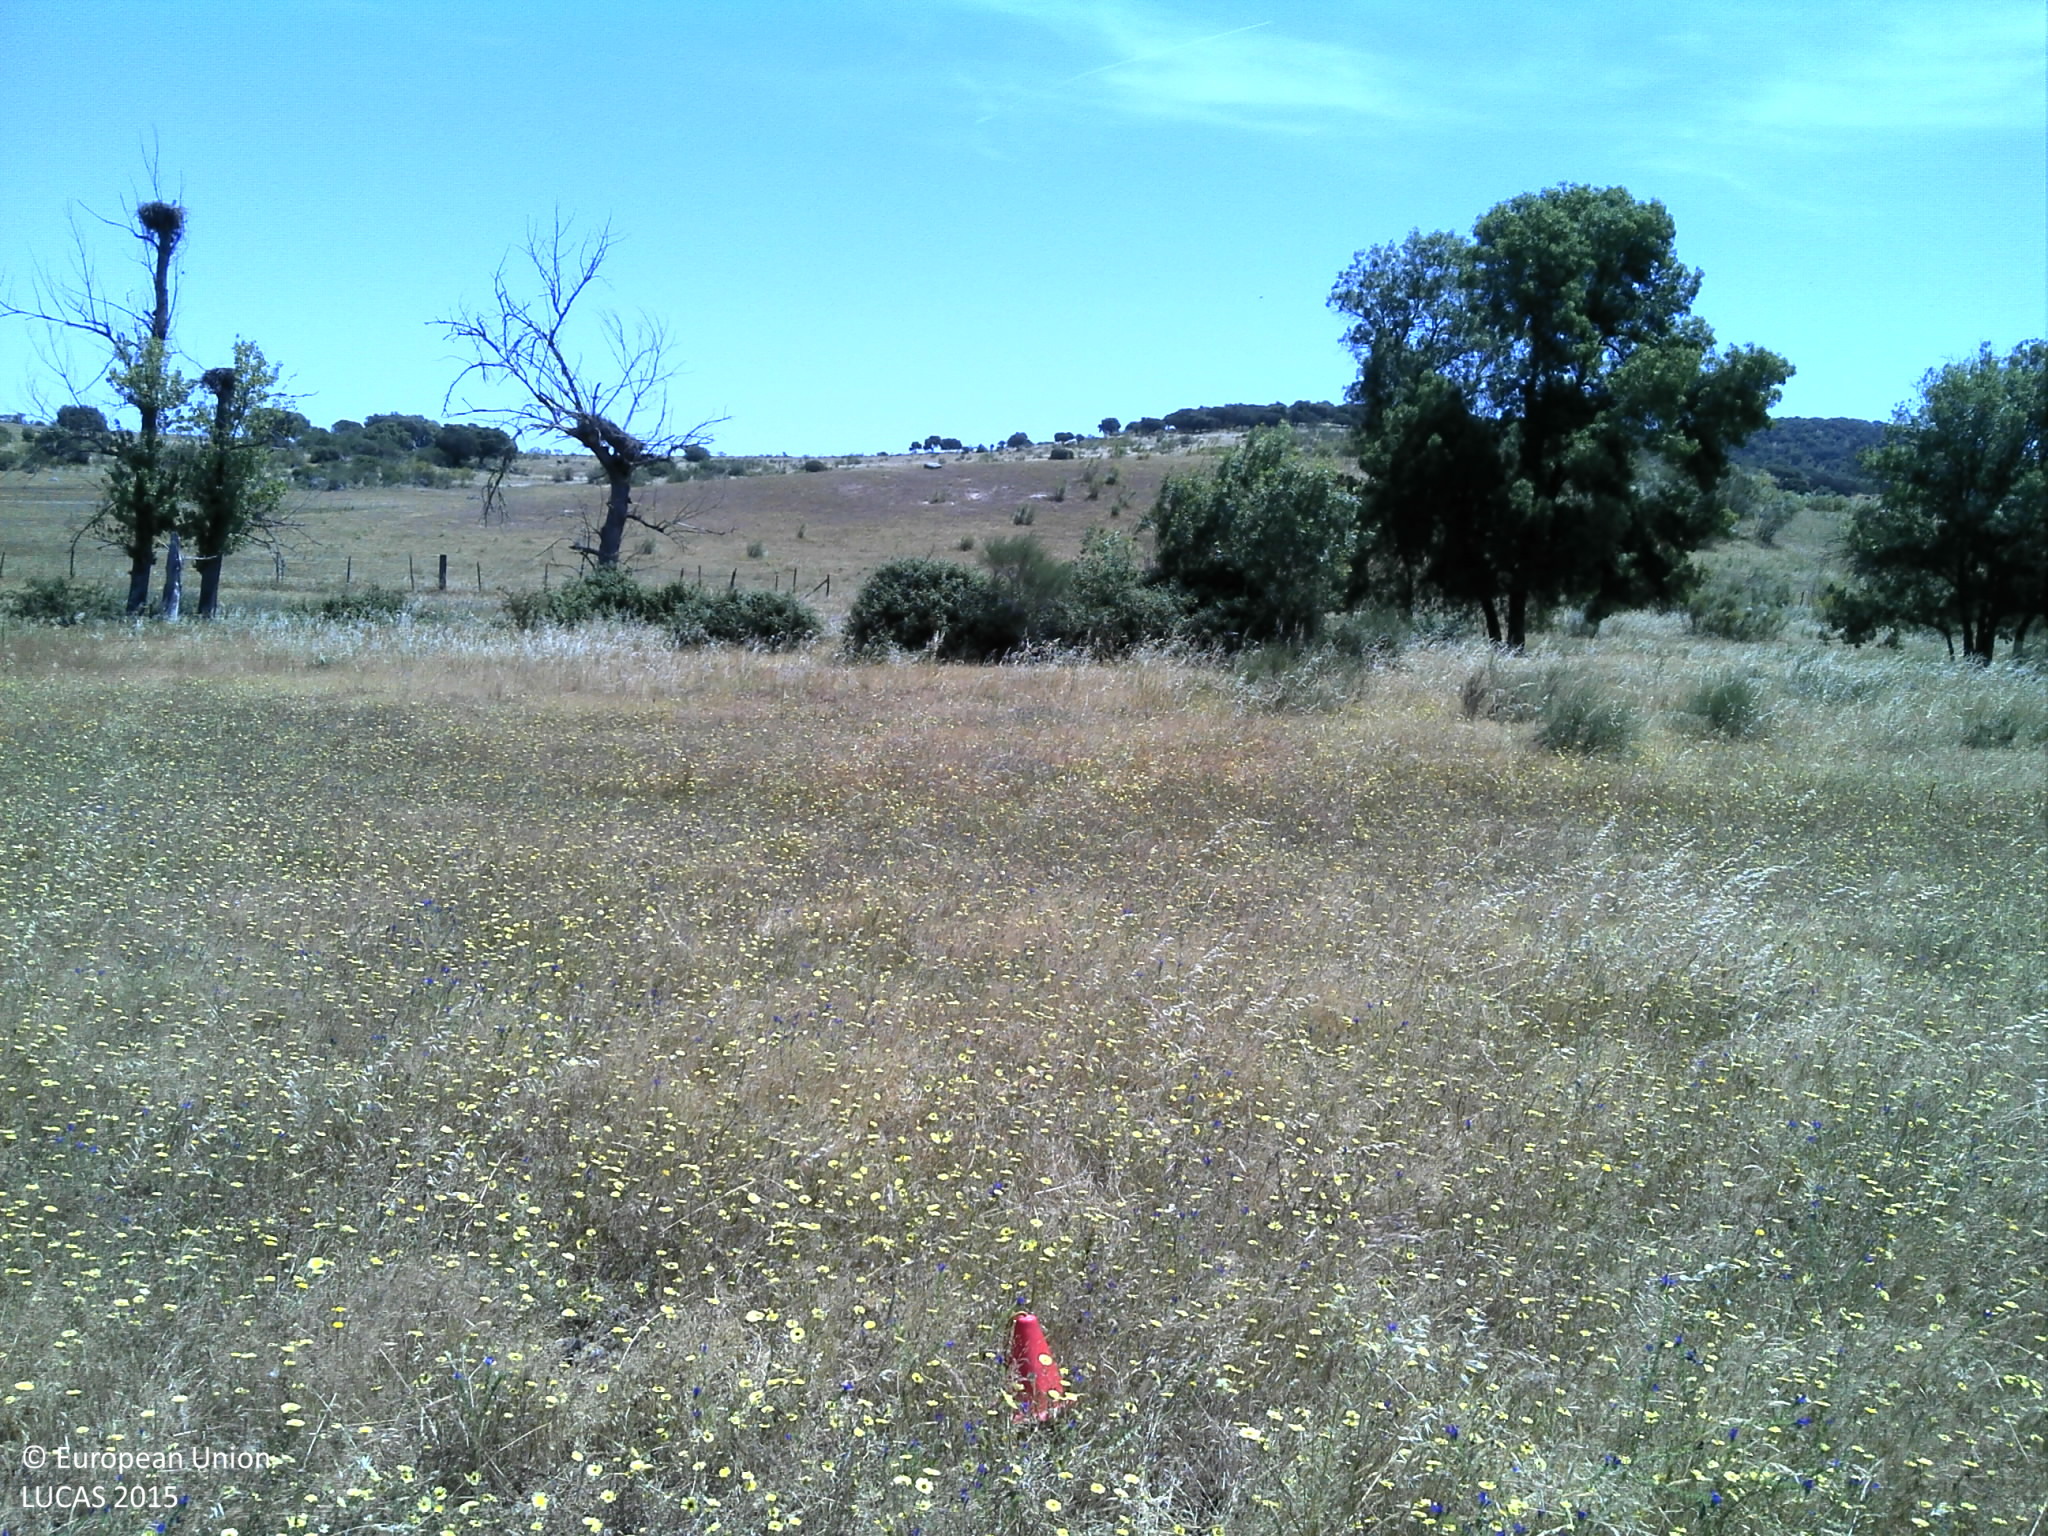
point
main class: Grassland
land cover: Grassland without tree/shrub cover
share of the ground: 50 - 75 %
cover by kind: herbaceous plants 60 %, unconsolidated bare surface 40 %
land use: Agriculture (excluding fallow land and kitchen gardens)
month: May
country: PT
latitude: 39.2404
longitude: -7.6685
